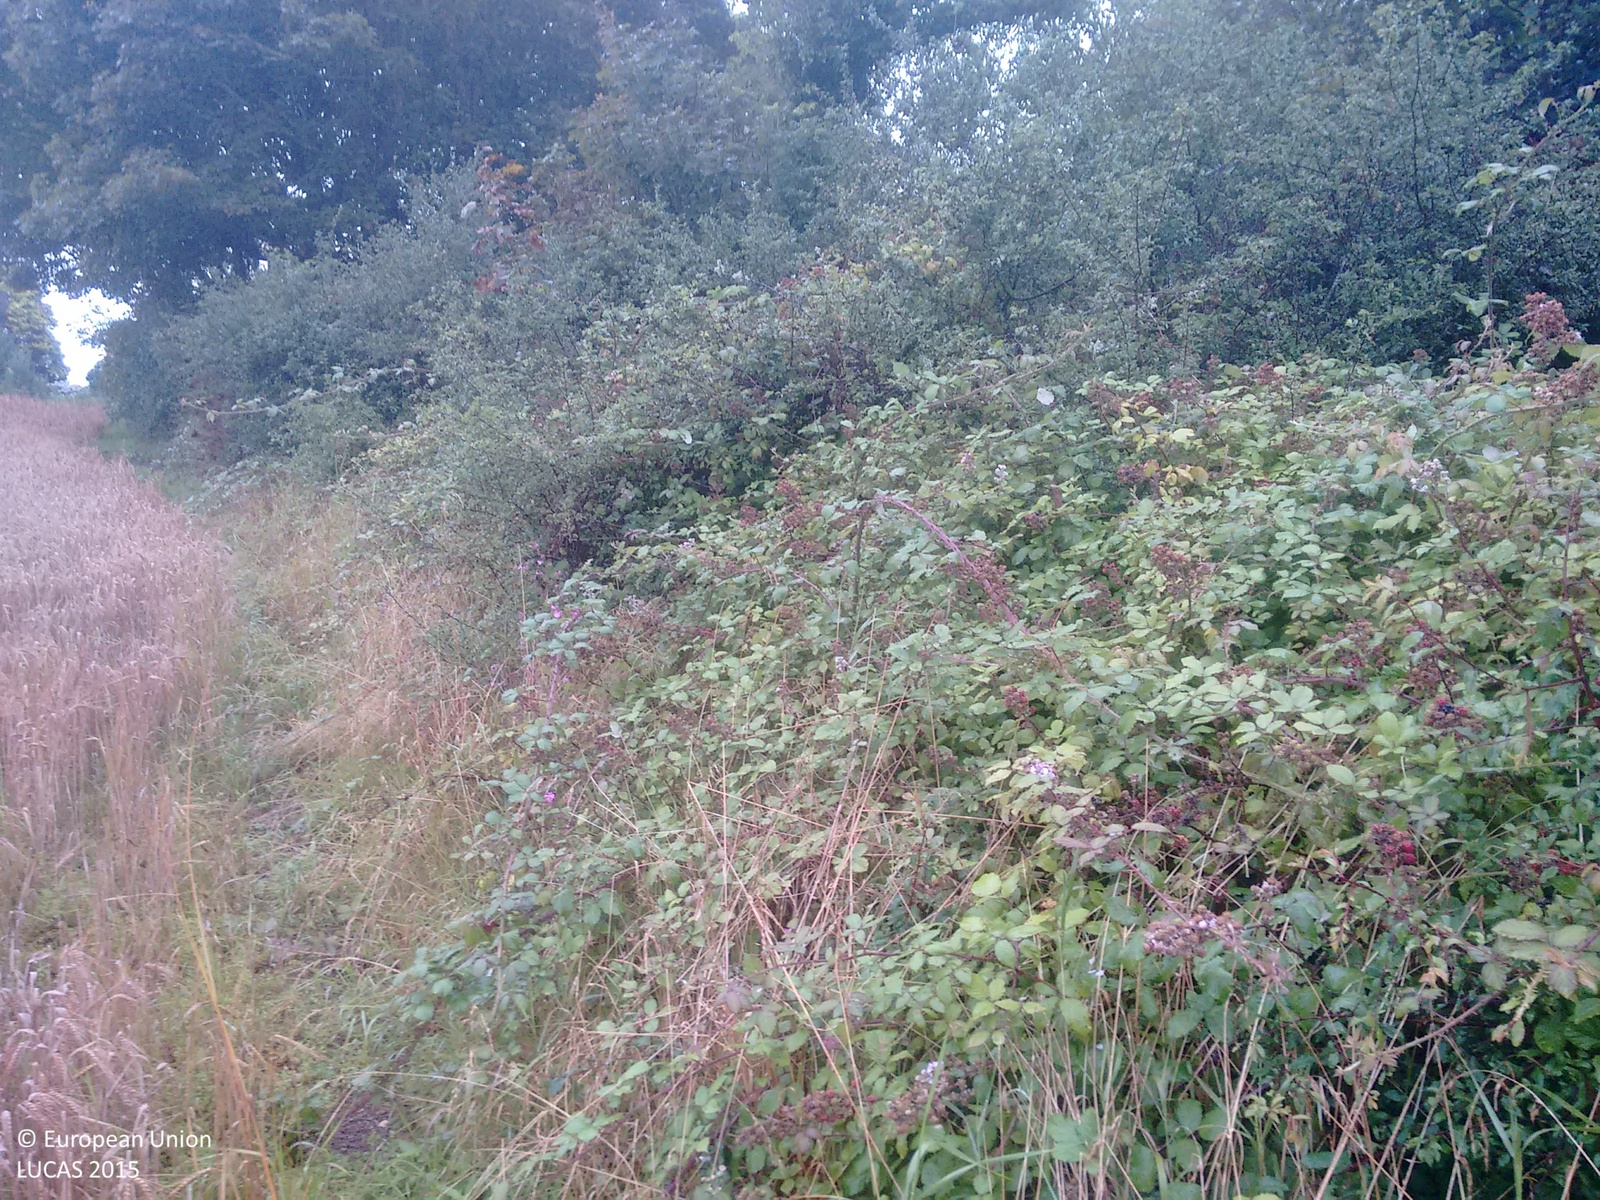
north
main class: Cropland
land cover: Barley
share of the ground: > 75 %
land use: Agriculture (excluding fallow land and kitchen gardens)
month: August
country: GB
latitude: 50.1154
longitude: -5.1525
